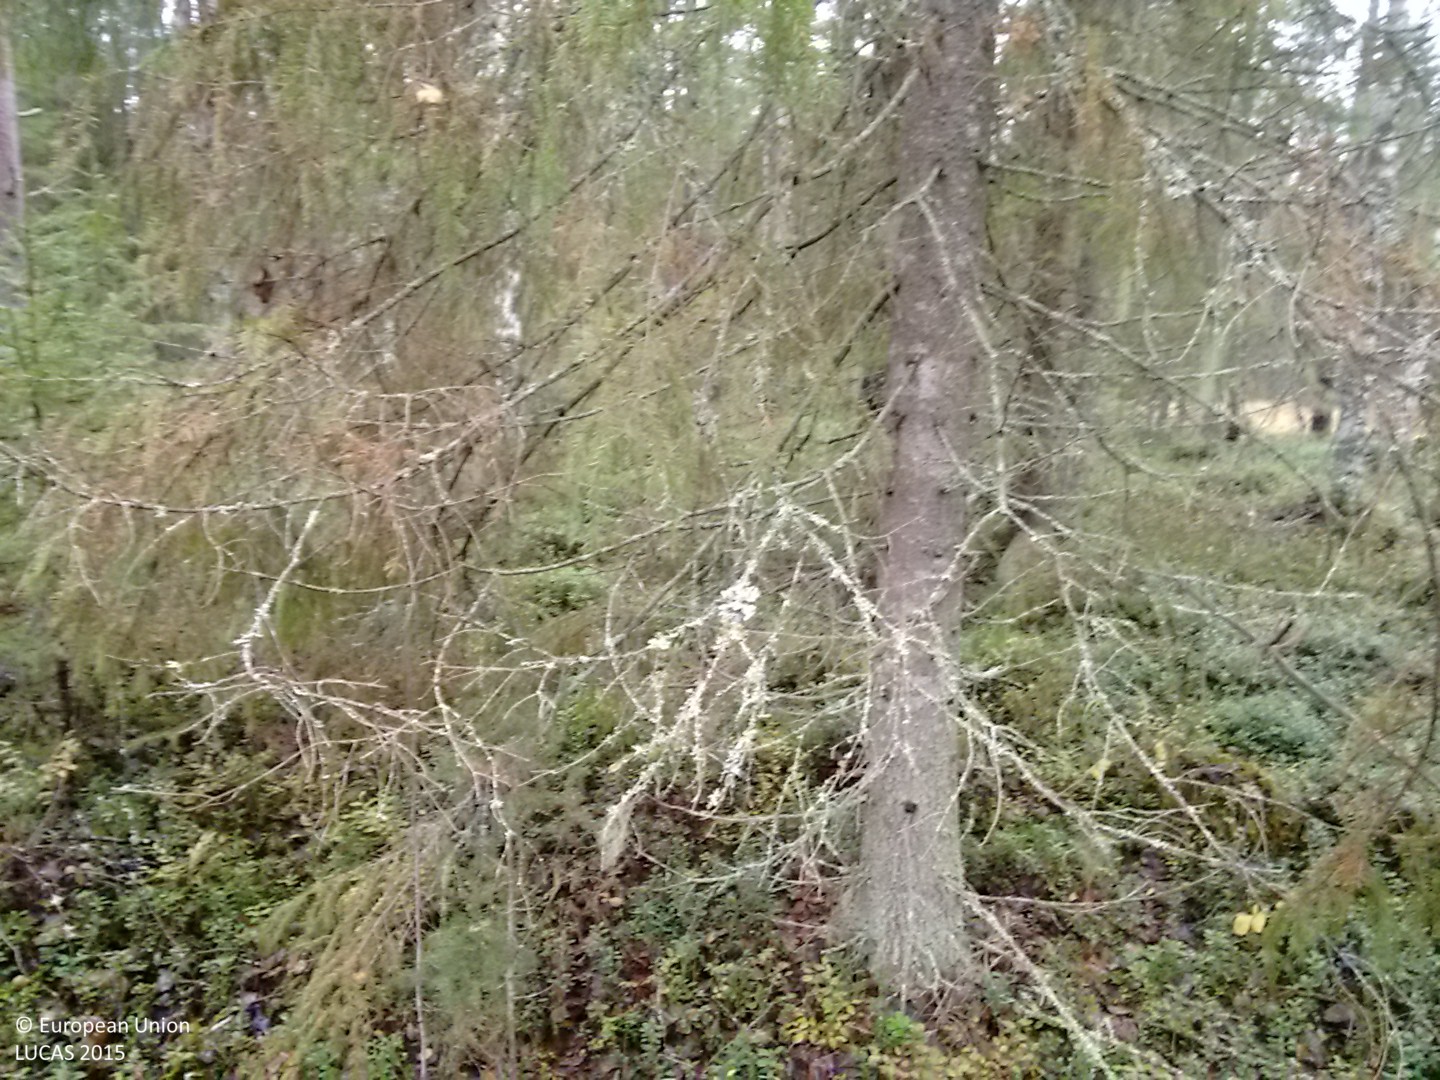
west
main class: Woodland
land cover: Spruce dominated mixed woodland
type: boreal forest
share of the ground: > 75 %
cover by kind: coniferous forest trees 60 %, broadleaved forest trees 25 %, shrubs 15 %
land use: Forestry
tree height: > 5 m
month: October
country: FI
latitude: 64.4722
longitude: 25.2034
